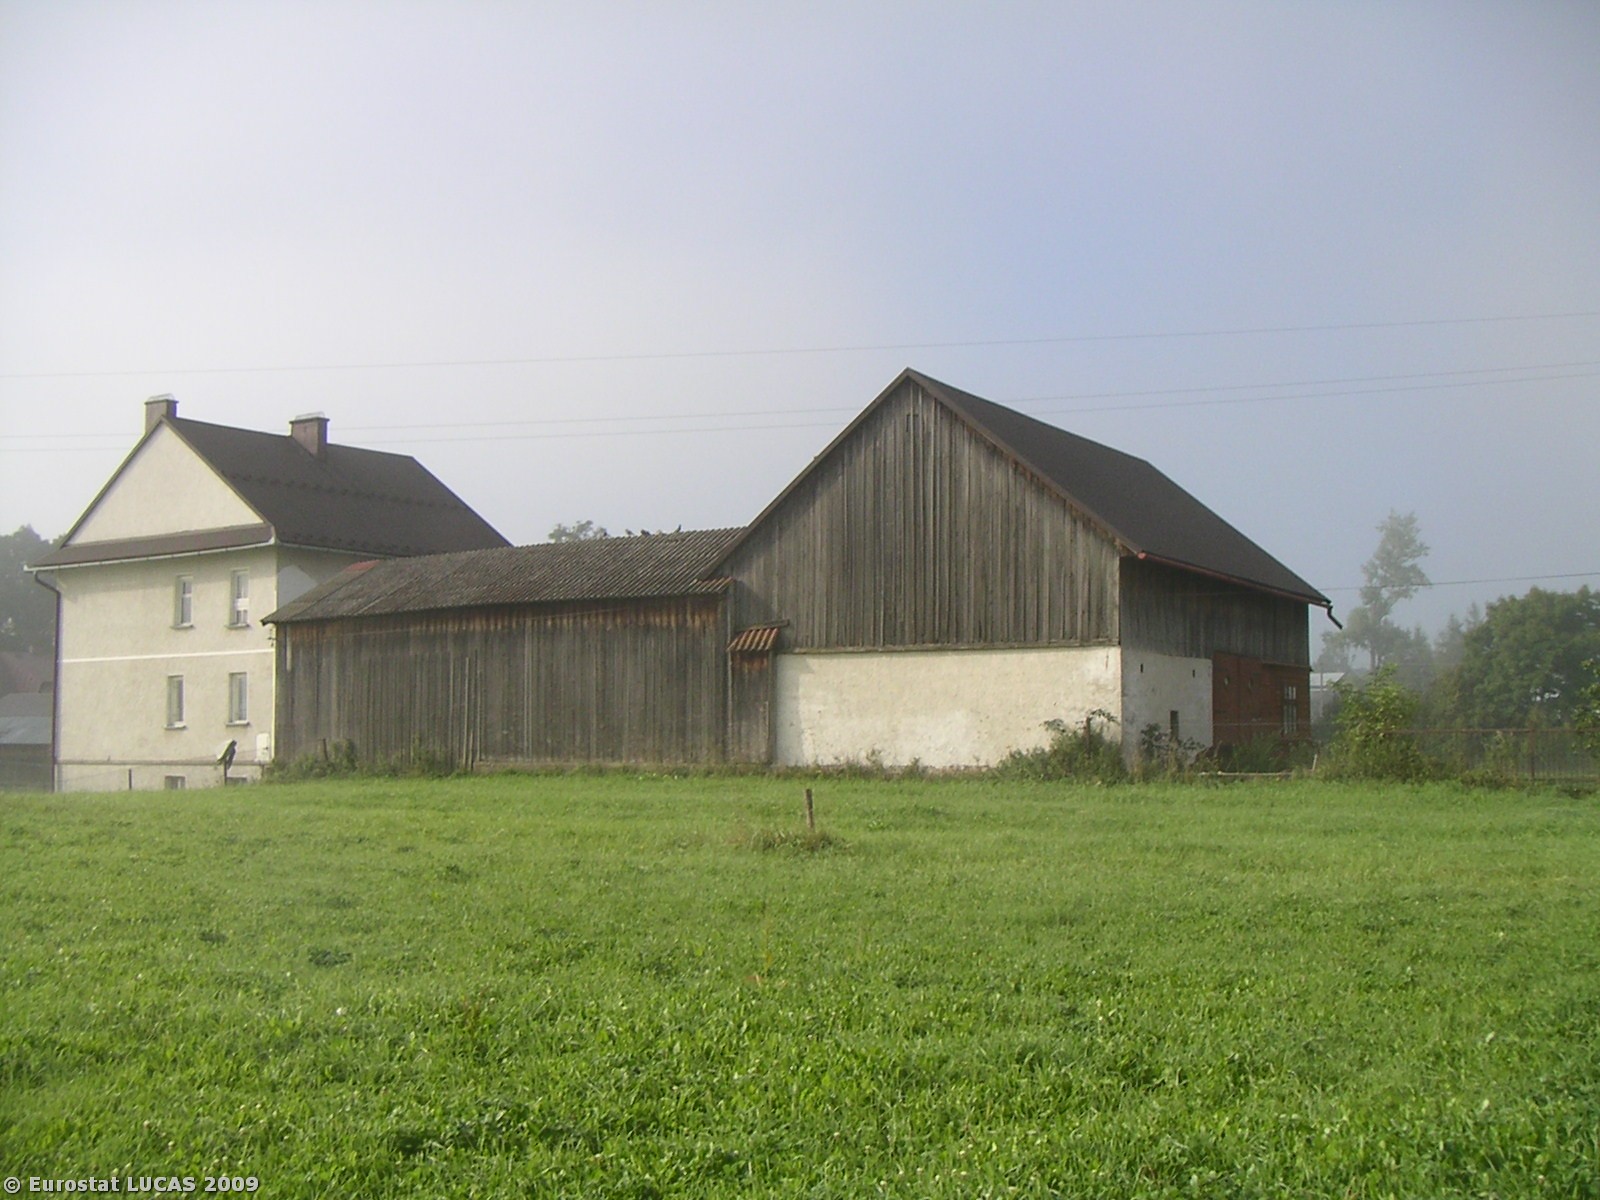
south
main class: Cropland
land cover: Clovers
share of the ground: > 75 %
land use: Agriculture (excluding fallow land and kitchen gardens)
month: September
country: PL
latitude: 49.4474
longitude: 19.8646
